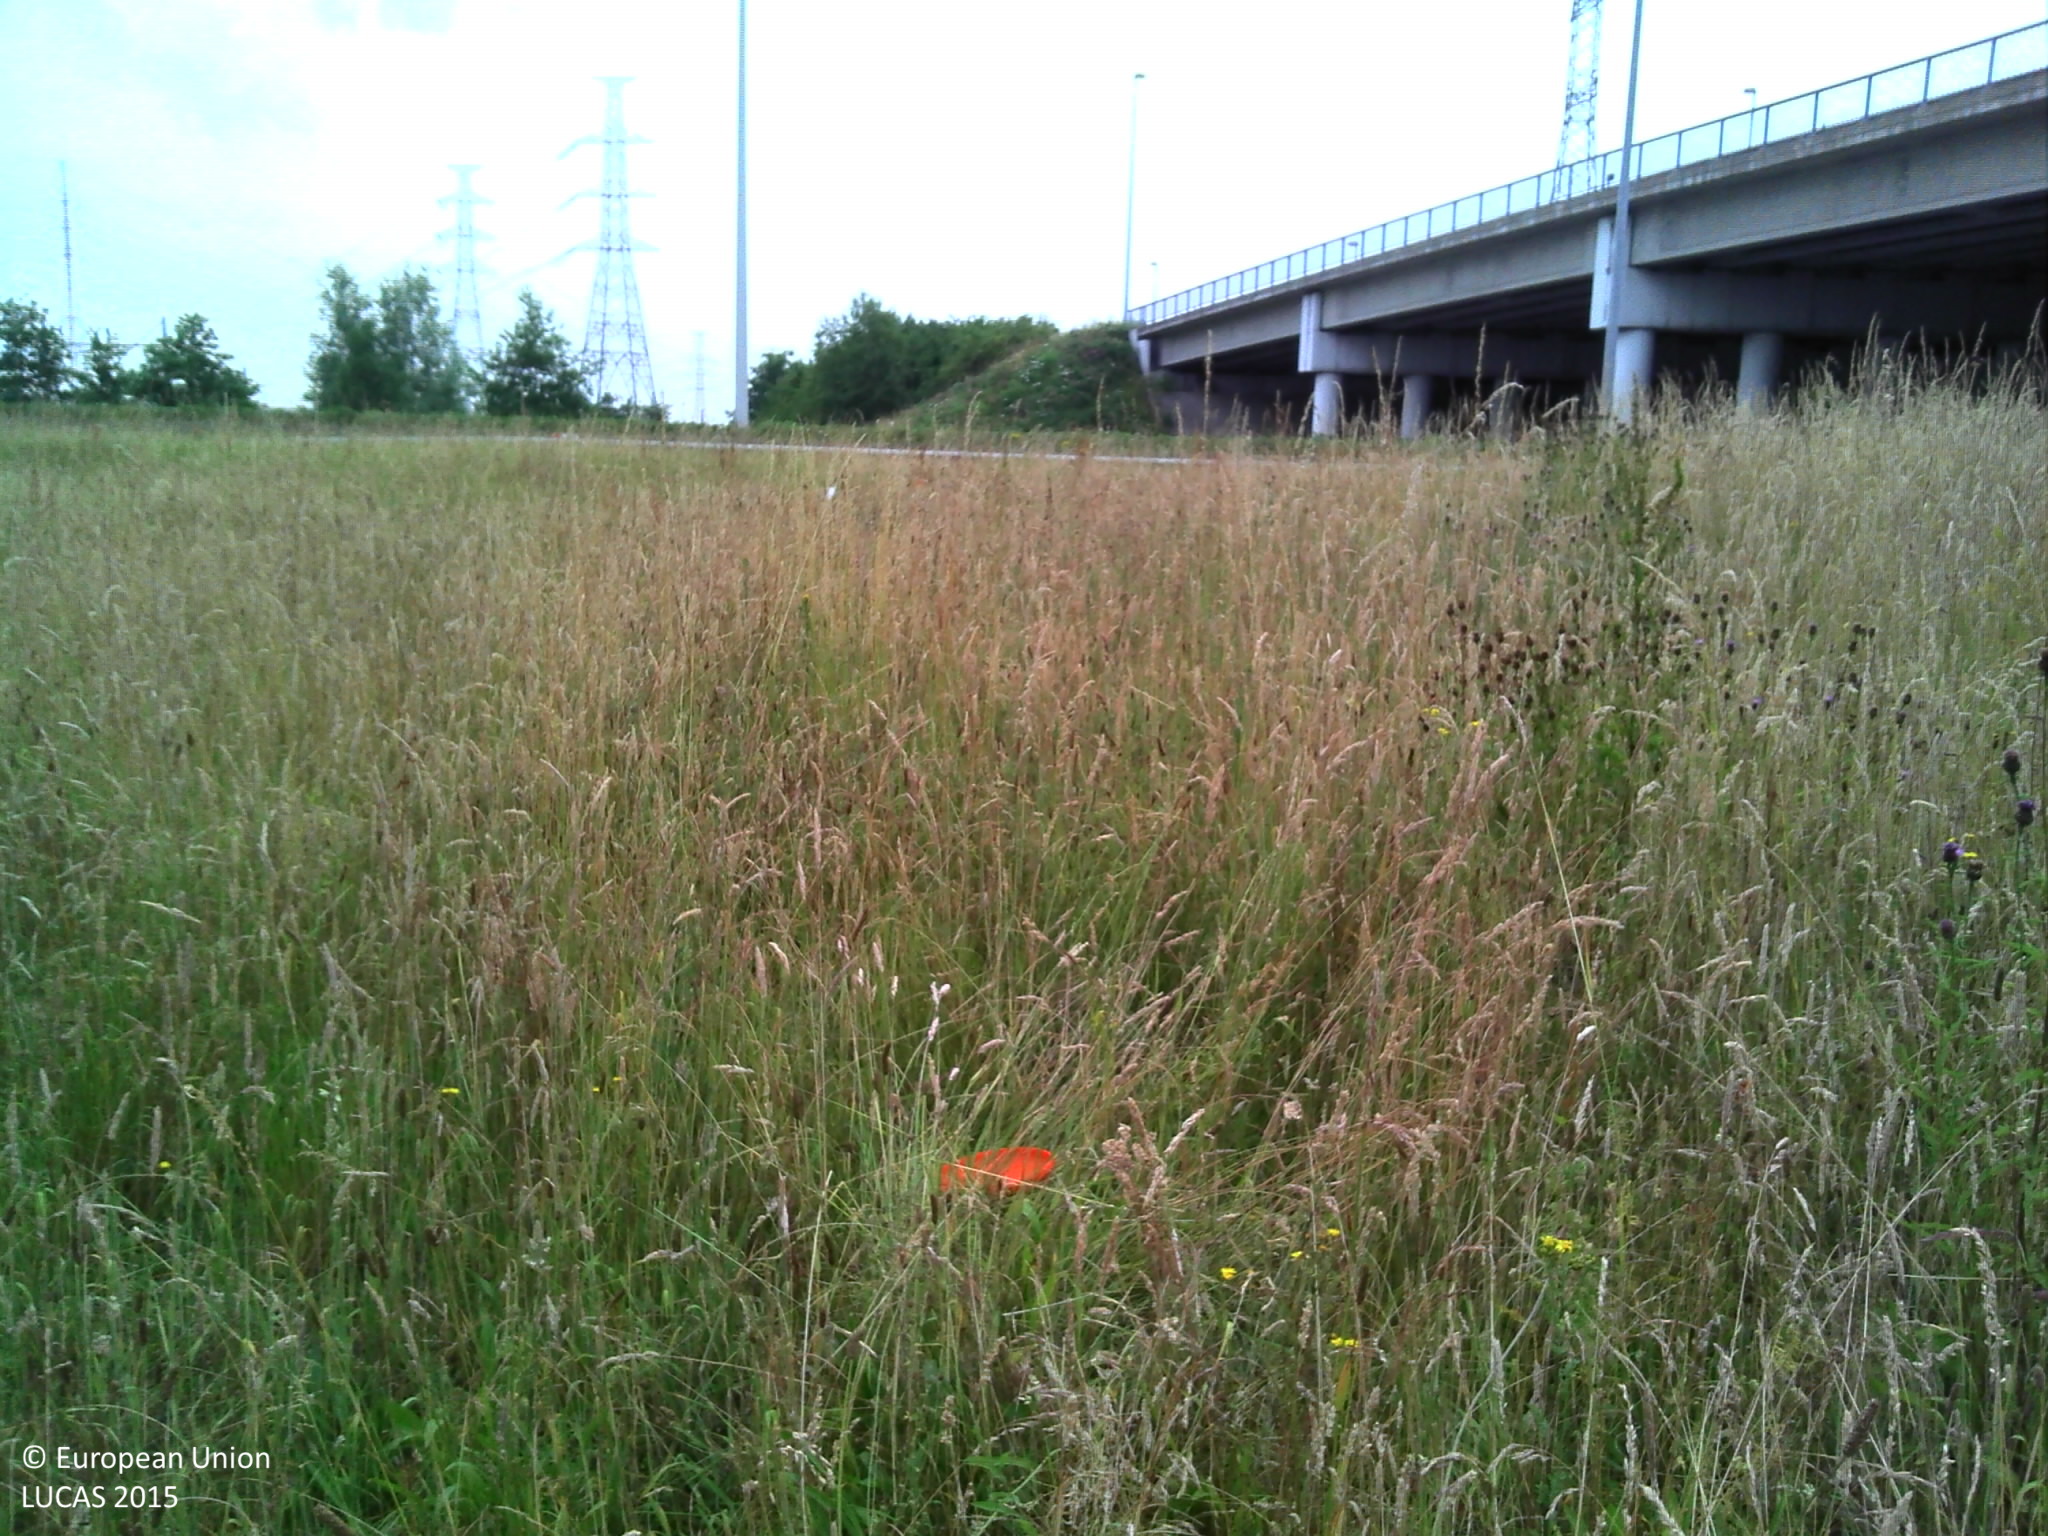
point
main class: Grassland
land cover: Spontaneously vegetated surfaces
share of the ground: > 75 %
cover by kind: herbaceous plants 100 %
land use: Semi-natural and natural areas not in use
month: July
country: BE
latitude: 51.2094
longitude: 3.5365
